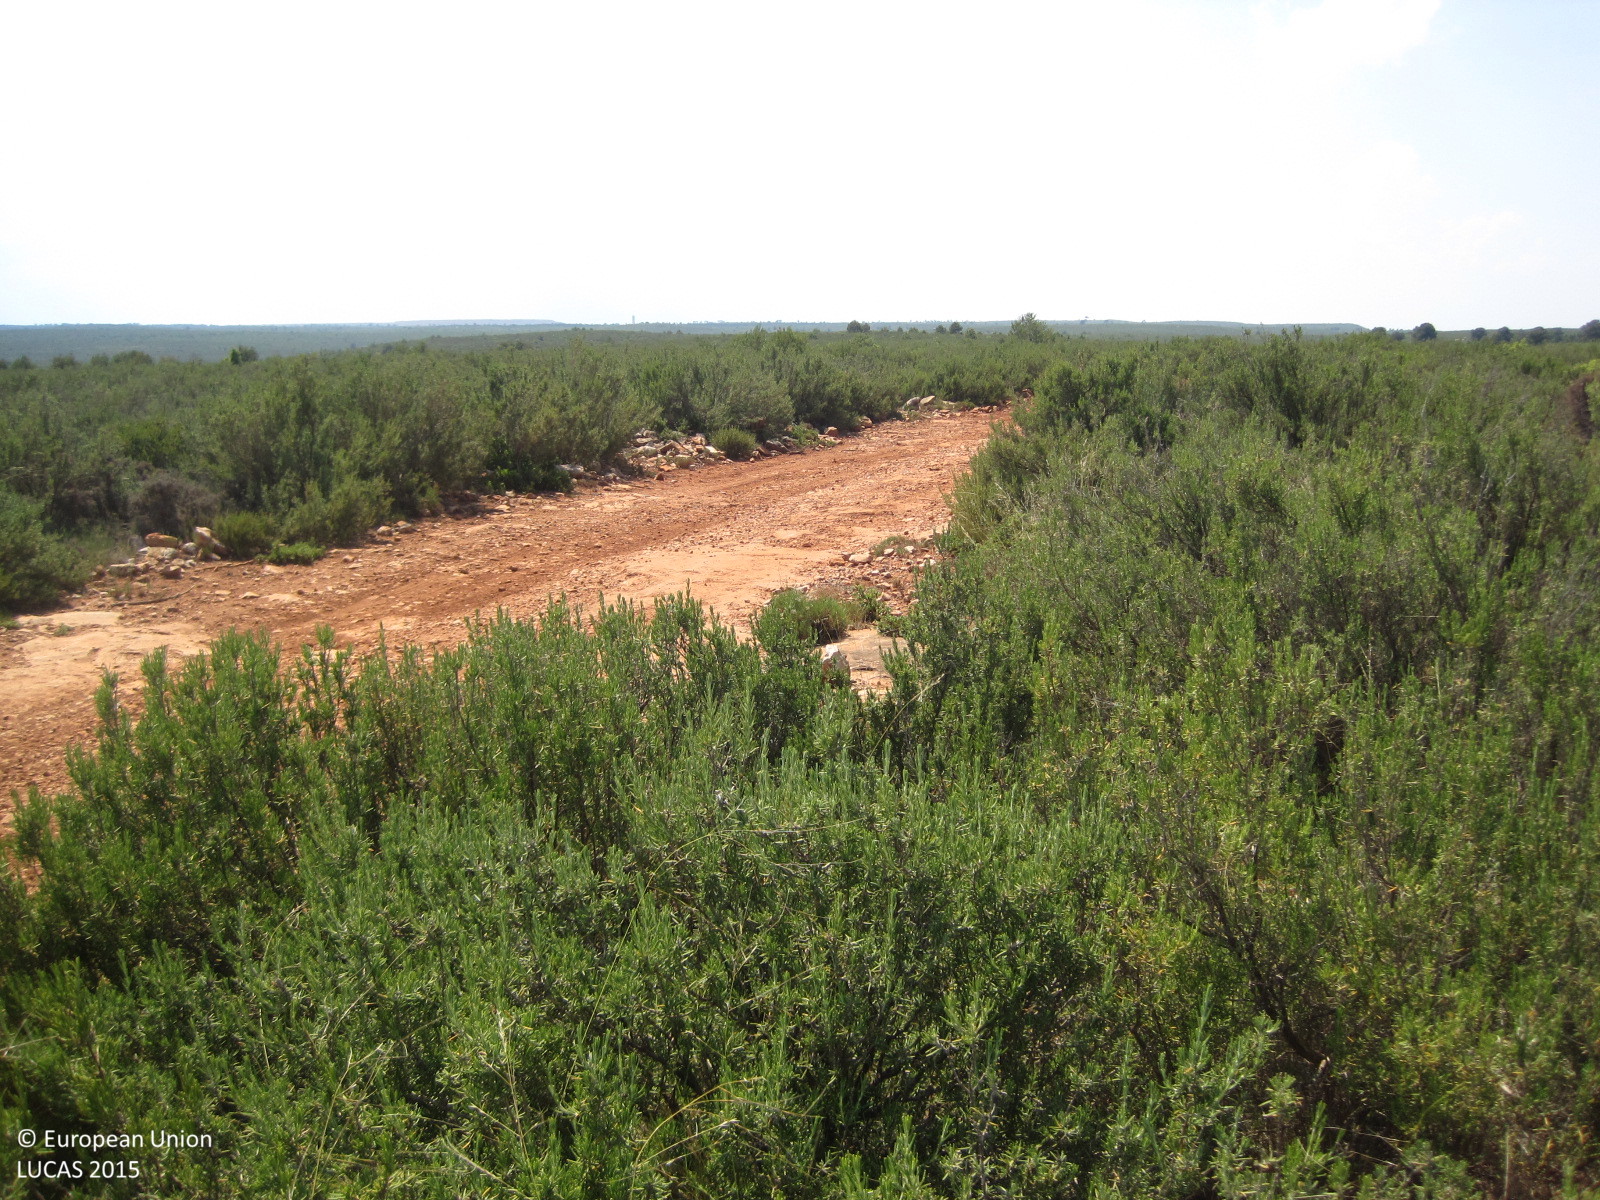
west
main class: Shrubland
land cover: Shrubland without tree cover
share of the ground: > 75 %
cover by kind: shrubs 85 %, consolidated bare surface 10 %, herbaceous plants 5 %
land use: Semi-natural and natural areas not in use
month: June
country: ES
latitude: 39.2437
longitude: -0.8537
